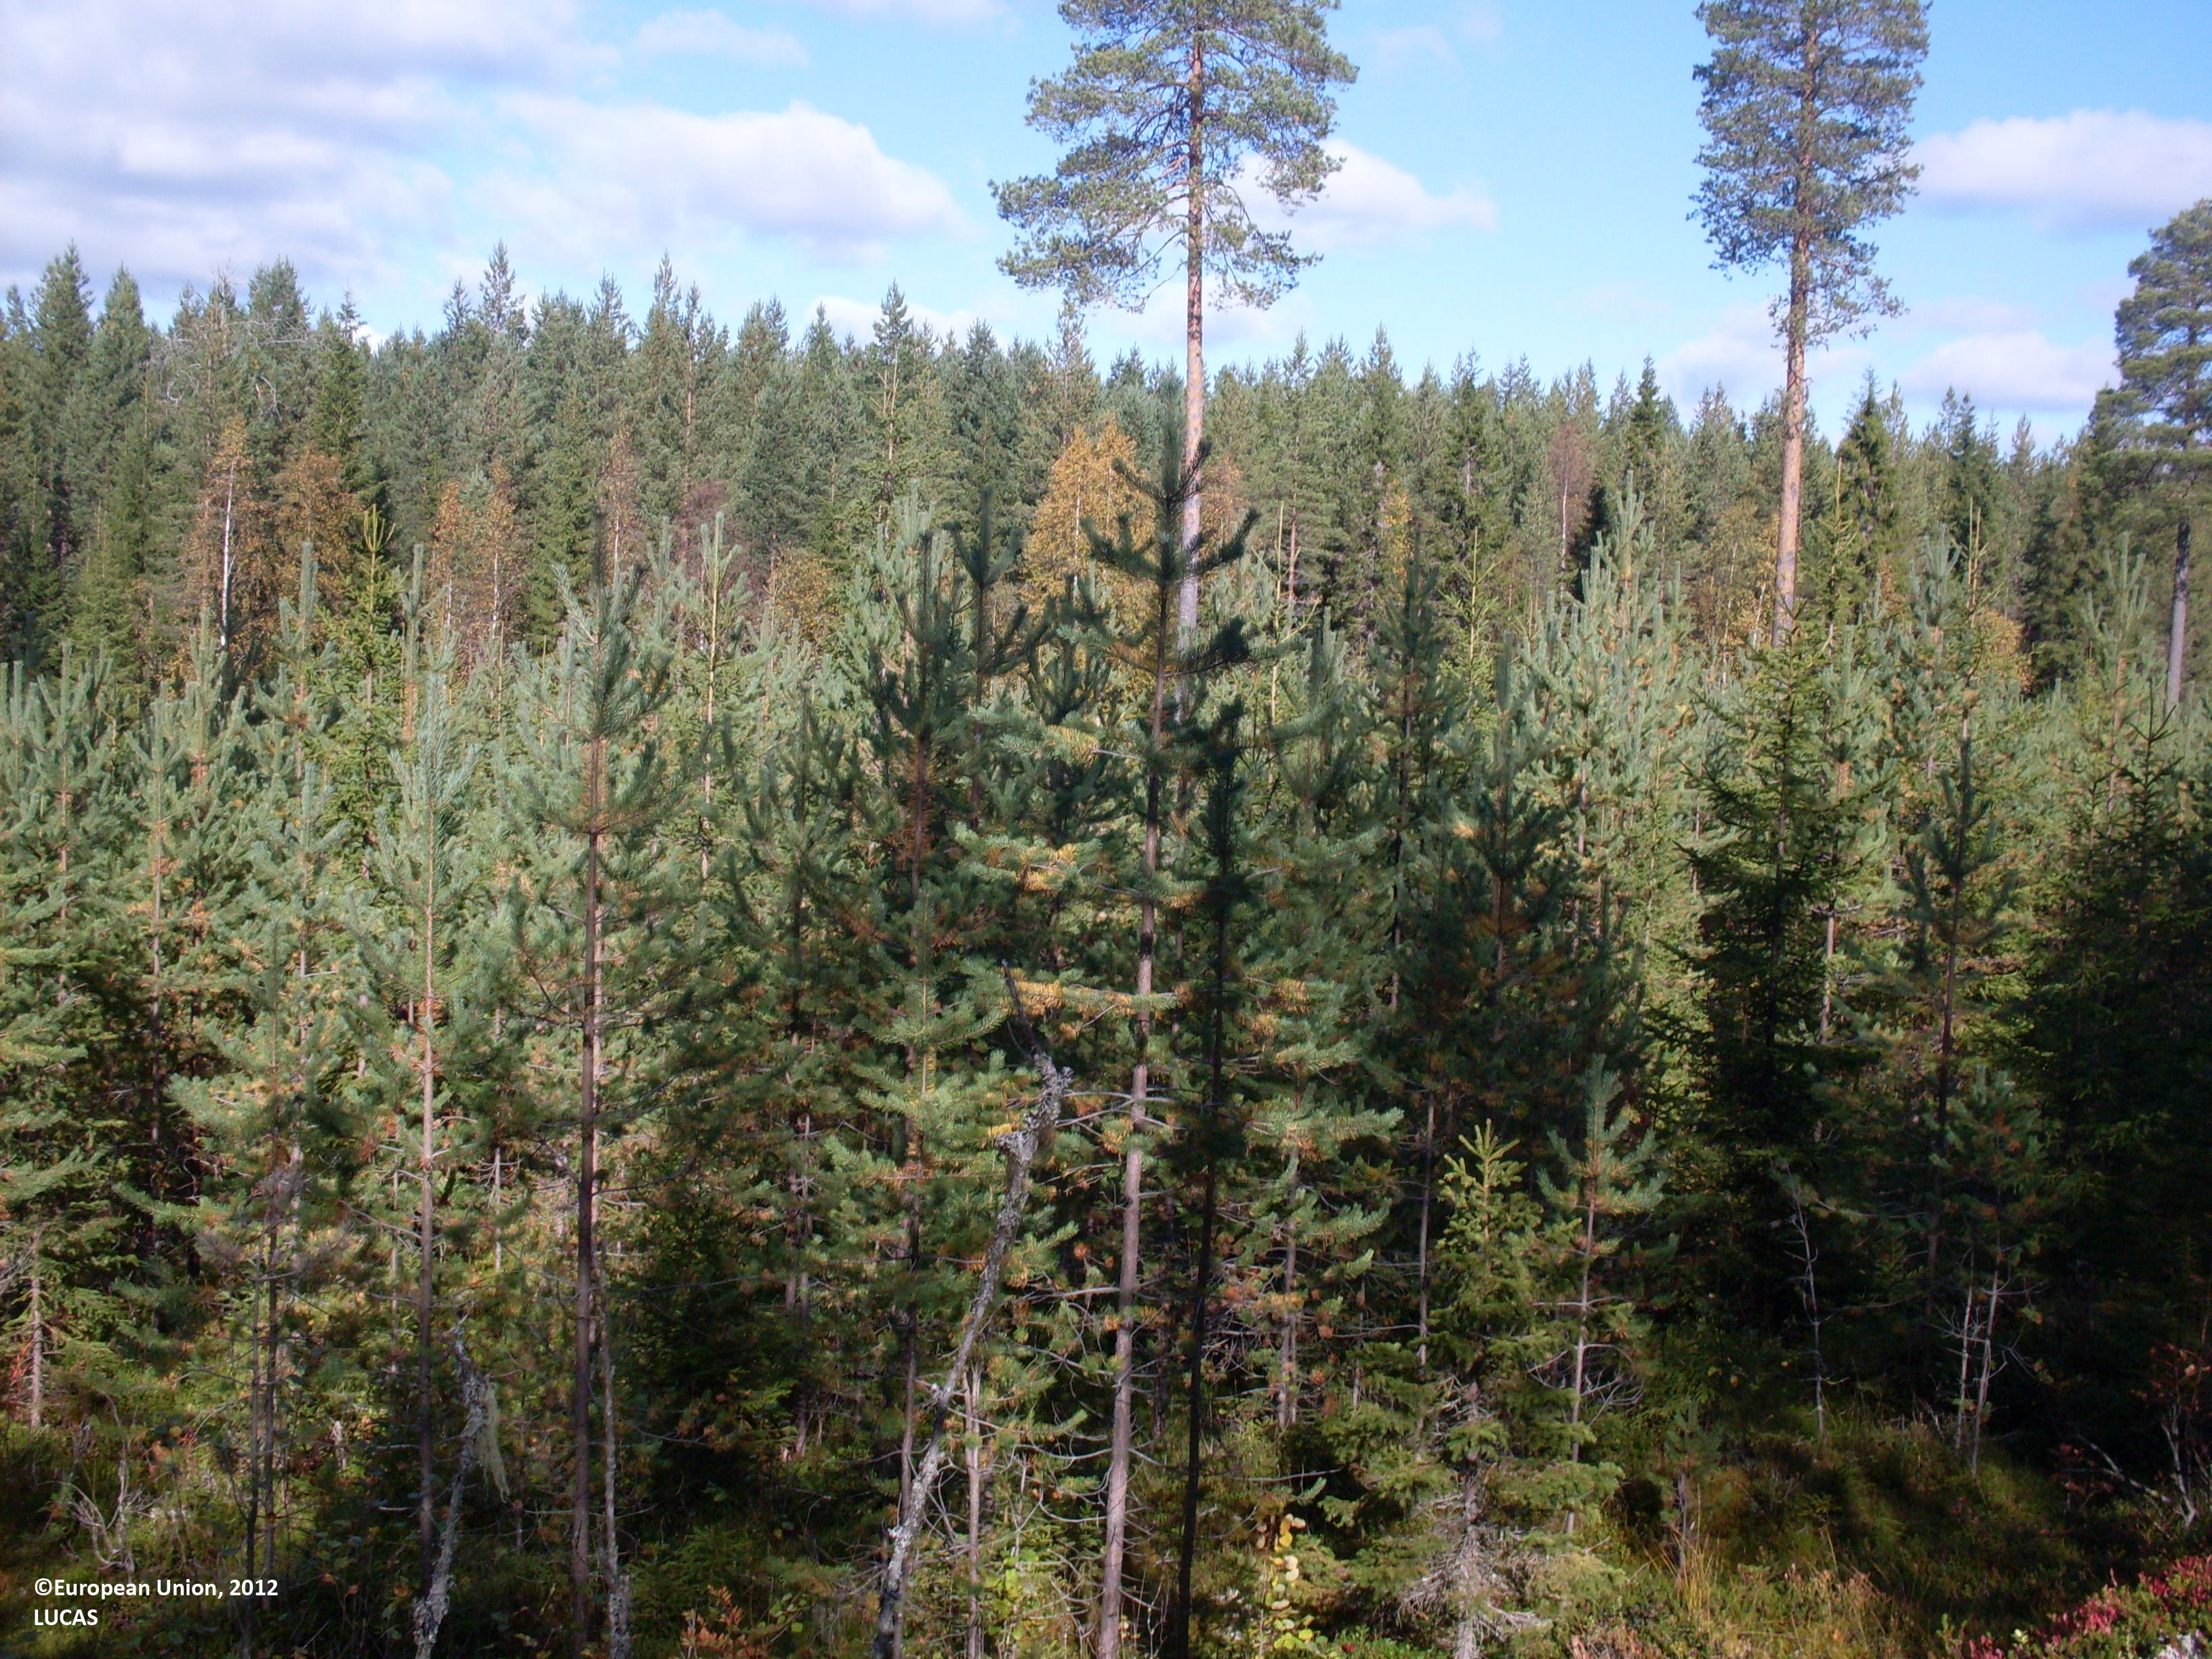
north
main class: Woodland
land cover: Pine dominated coniferous woodland
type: boreal forest
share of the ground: 50 - 75 %
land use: Forestry
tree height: > 5 m
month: September
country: FI
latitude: 64.1023
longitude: 29.9584
